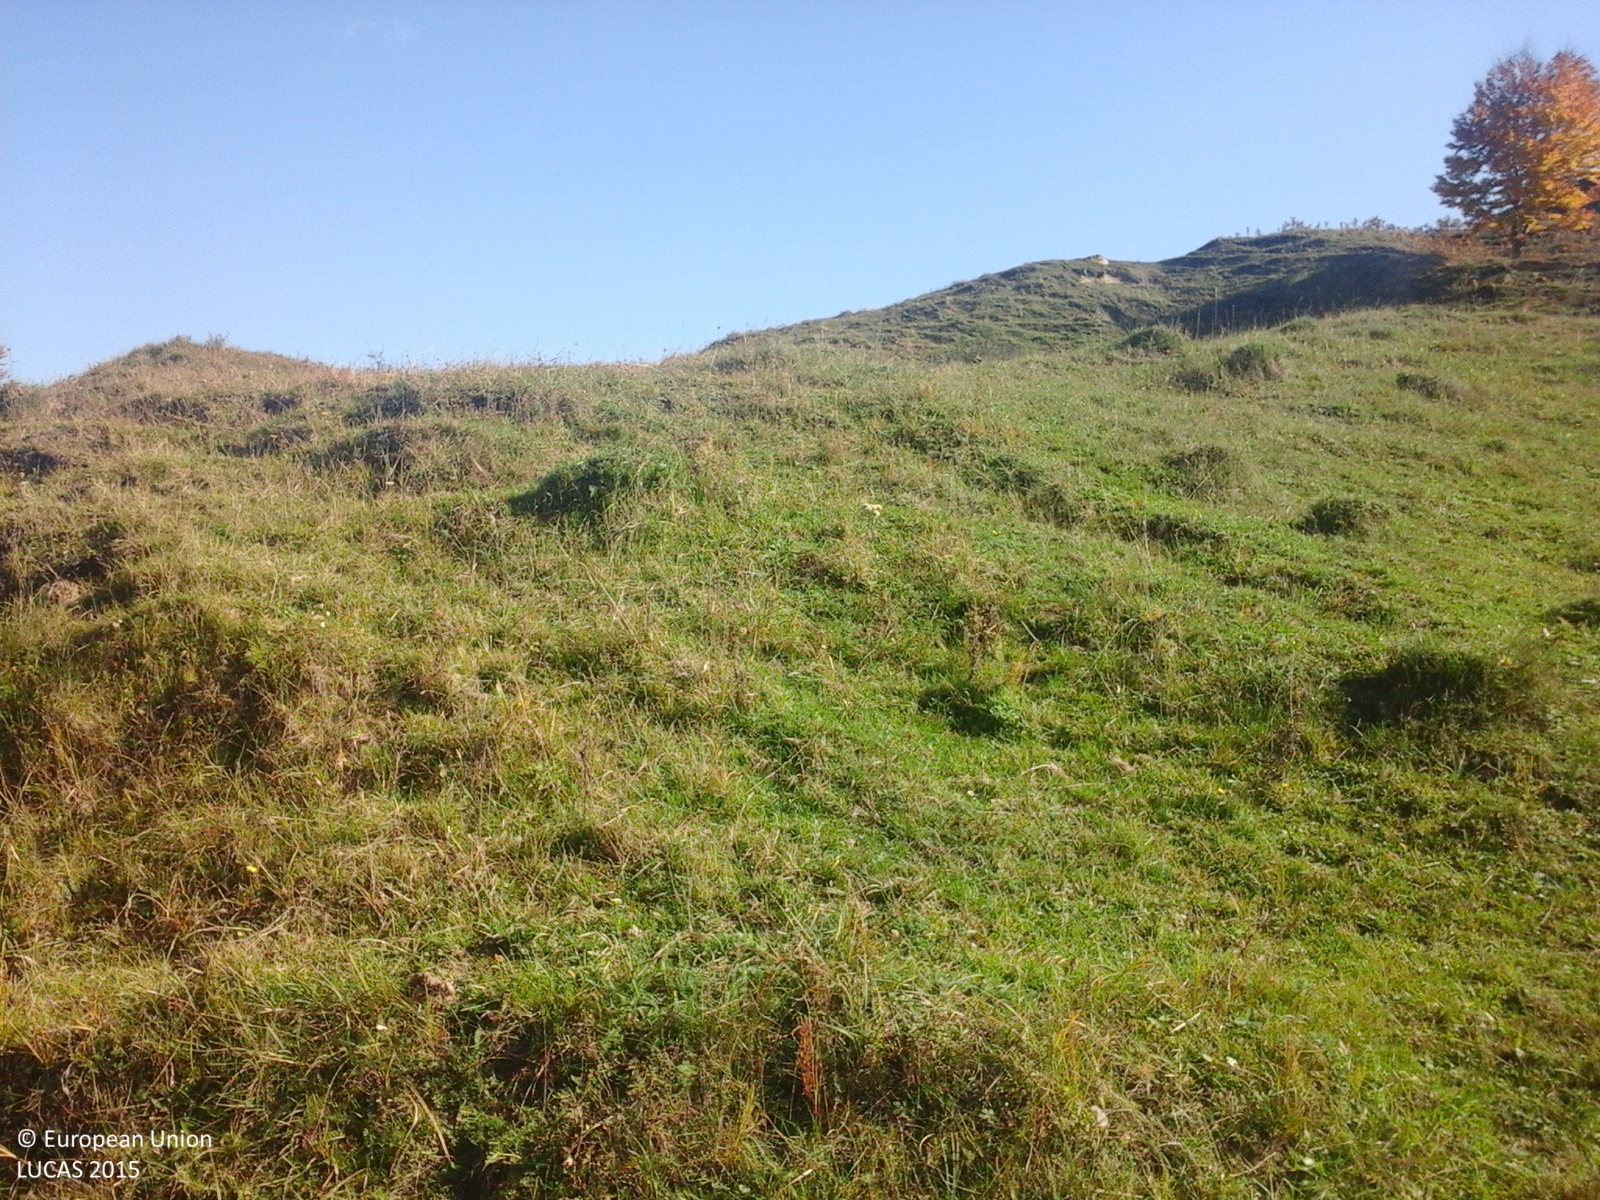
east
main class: Grassland
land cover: Grassland without tree/shrub cover
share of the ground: > 75 %
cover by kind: herbaceous plants 100 %
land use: Agriculture (excluding fallow land and kitchen gardens)
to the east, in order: Grassland without tree/shrub cover; Tracks; Grassland without tree/shrub cover
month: October
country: RO
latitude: 46.0311
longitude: 26.7384
